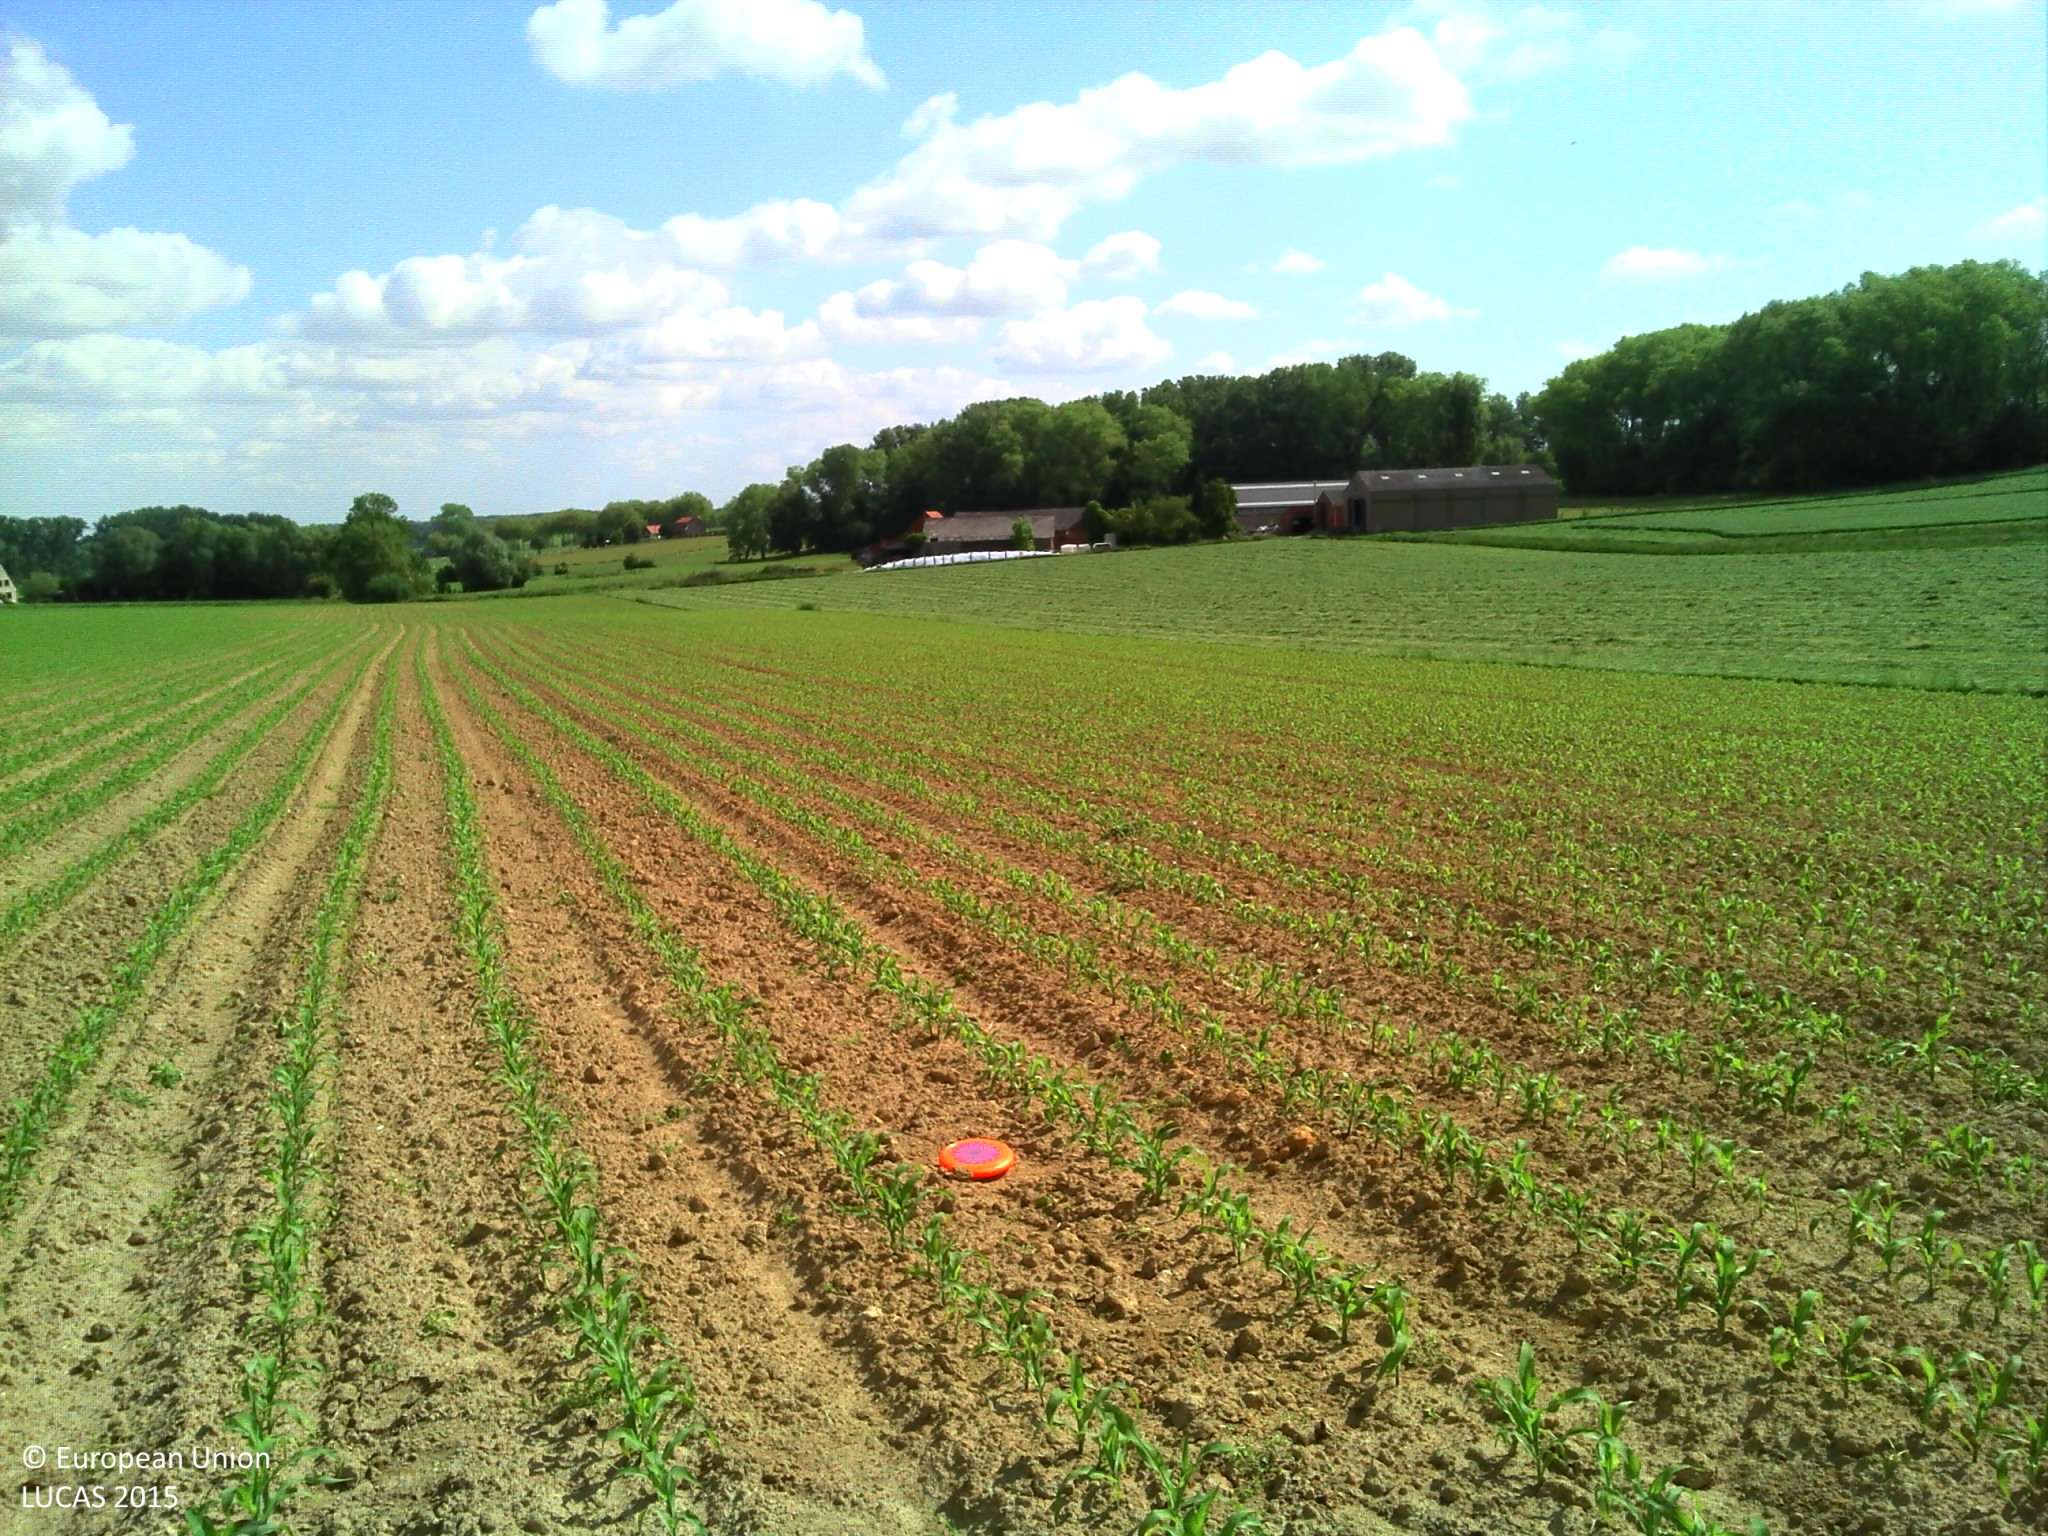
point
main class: Cropland
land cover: Maize
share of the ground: < 10 %
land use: Agriculture (excluding fallow land and kitchen gardens)
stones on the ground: < 10 %
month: June
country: BE
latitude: 50.7921
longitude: 2.8820
